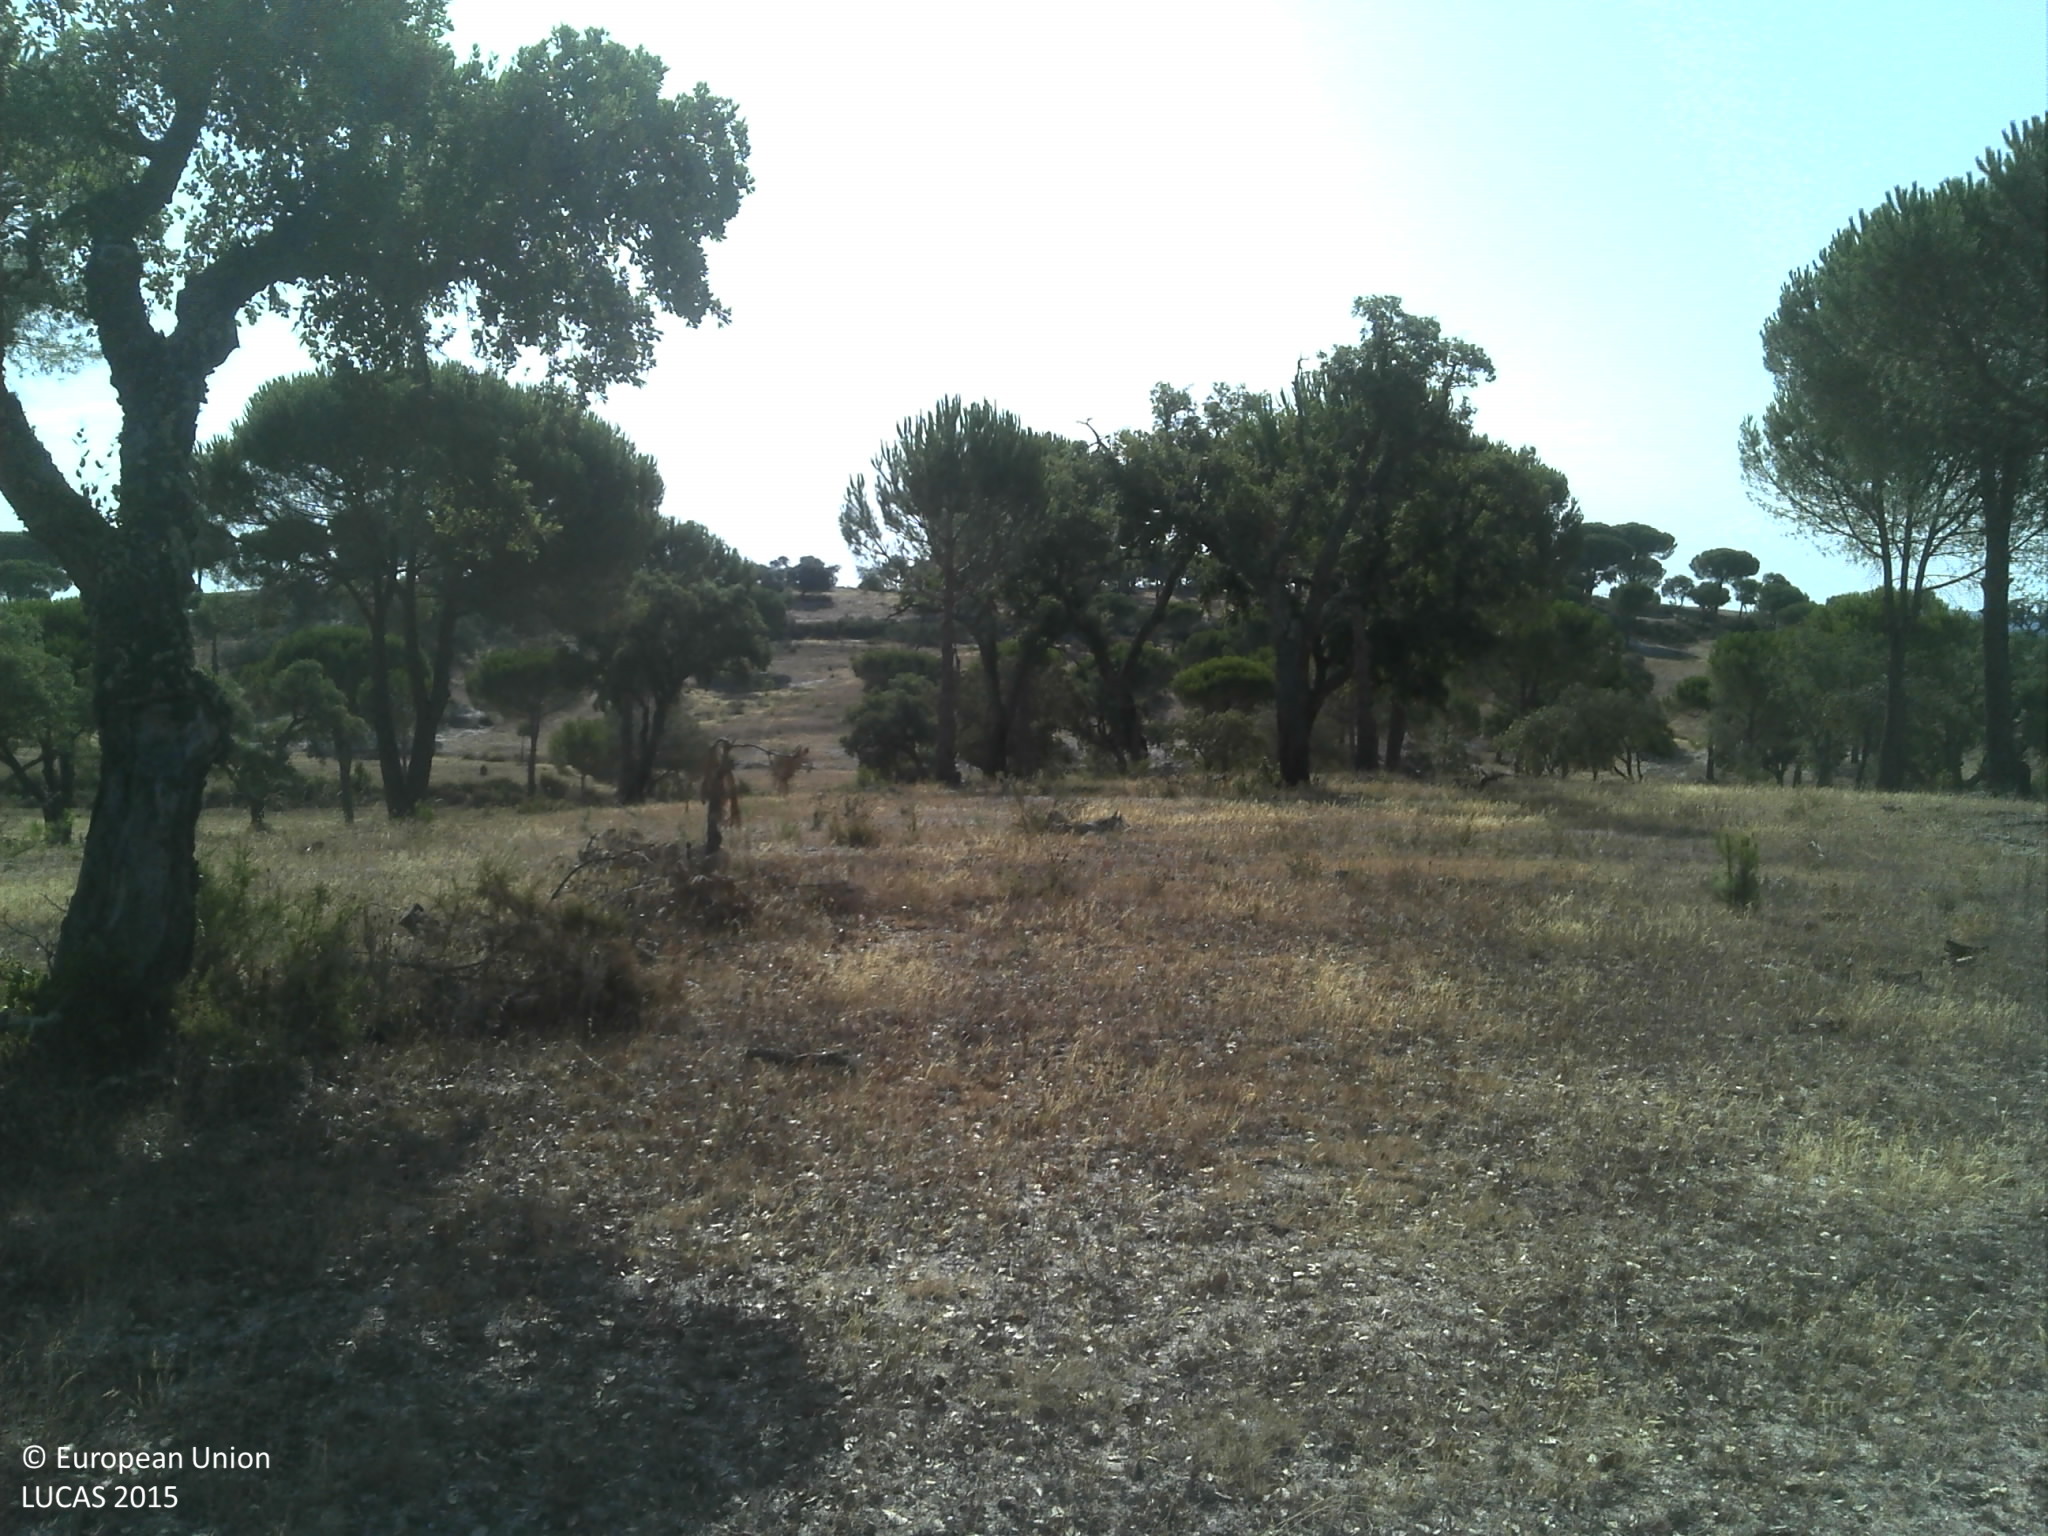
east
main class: Woodland
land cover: Broadleaved woodland
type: broadleaved evergreen forest
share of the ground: 25 - 50 %
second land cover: Grassland without tree/shrub cover
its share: 25 - 50 %
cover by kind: herbaceous plants 40 %, broadleaved forest trees 30 %, unconsolidated bare surface 30 %
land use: Forestry
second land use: Agriculture (excluding fallow land and kitchen gardens)
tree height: > 5 m
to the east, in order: Broadleaved woodland; Grassland without tree/shrub cover; Pine dominated coniferous woodland; Broadleaved woodland; Grassland without tree/shrub cover; Shruby margins; Ditches and canals; Shruby margins; Grassland without tree/shrub cover; Broadleaved woodland
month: July
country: PT
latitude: 39.1170
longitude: -8.3228
